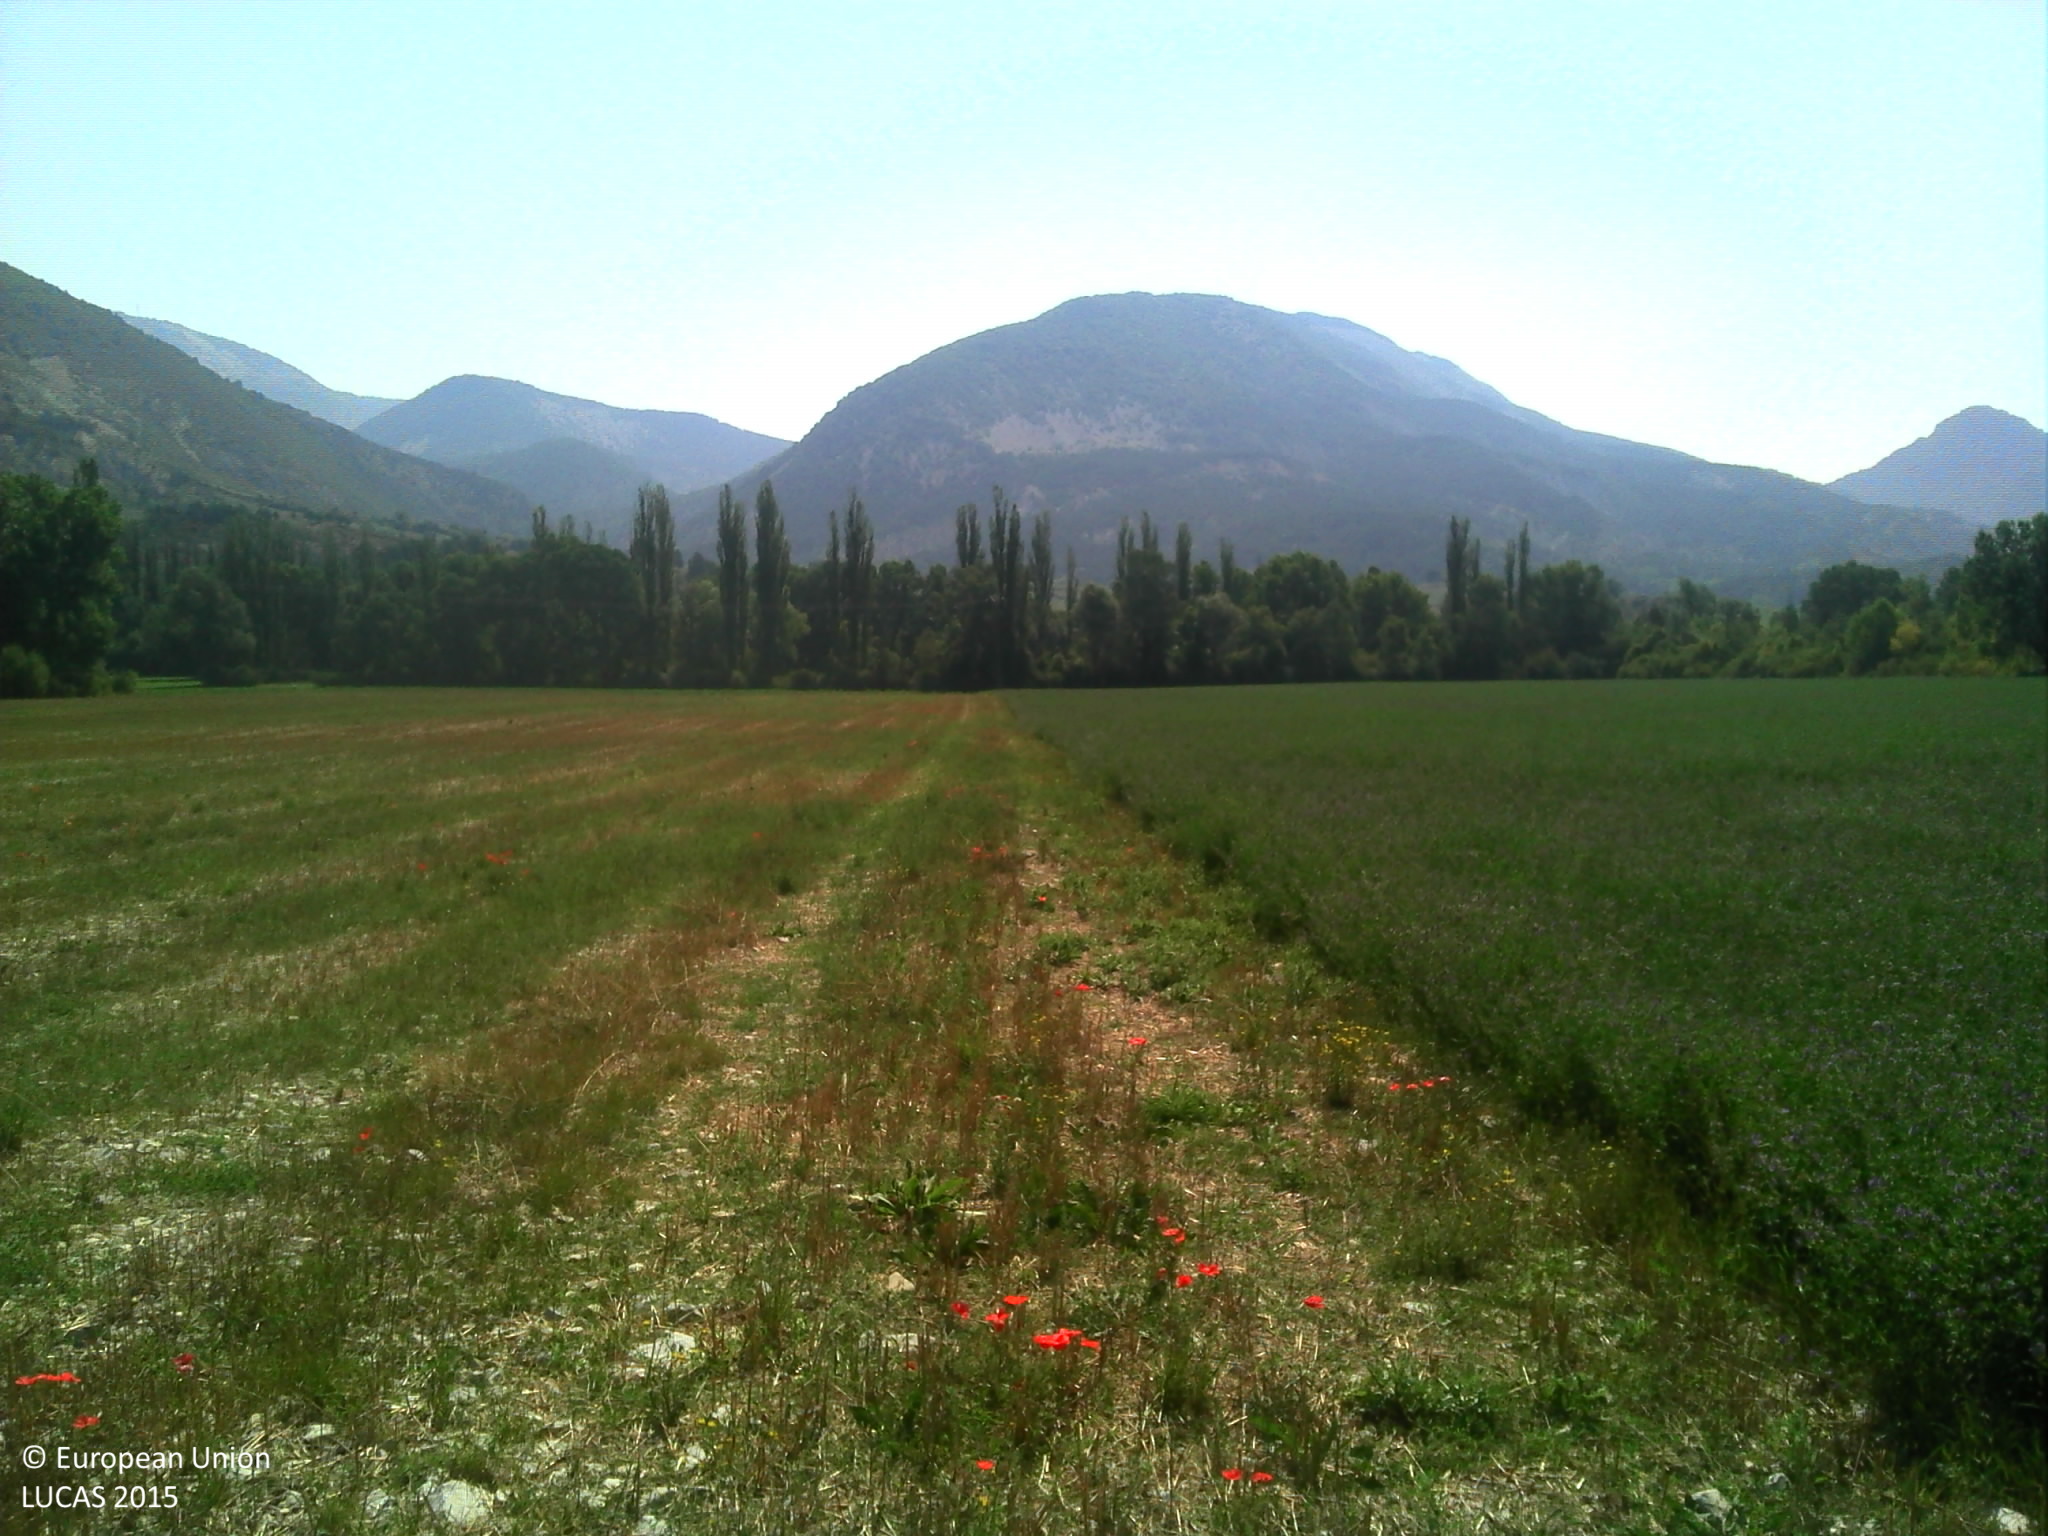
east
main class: Grassland
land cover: Spontaneously vegetated surfaces
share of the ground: > 75 %
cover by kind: herbaceous plants 100 %
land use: Agriculture (excluding fallow land and kitchen gardens)
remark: Harvested field
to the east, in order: Spontaneously vegetated surfaces; Electric lines; Spontaneously vegetated surfaces; Tracks; Broadleaved woodland; Spontaneously vegetated surfaces
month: August
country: FR
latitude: 44.0165
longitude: 6.3775
